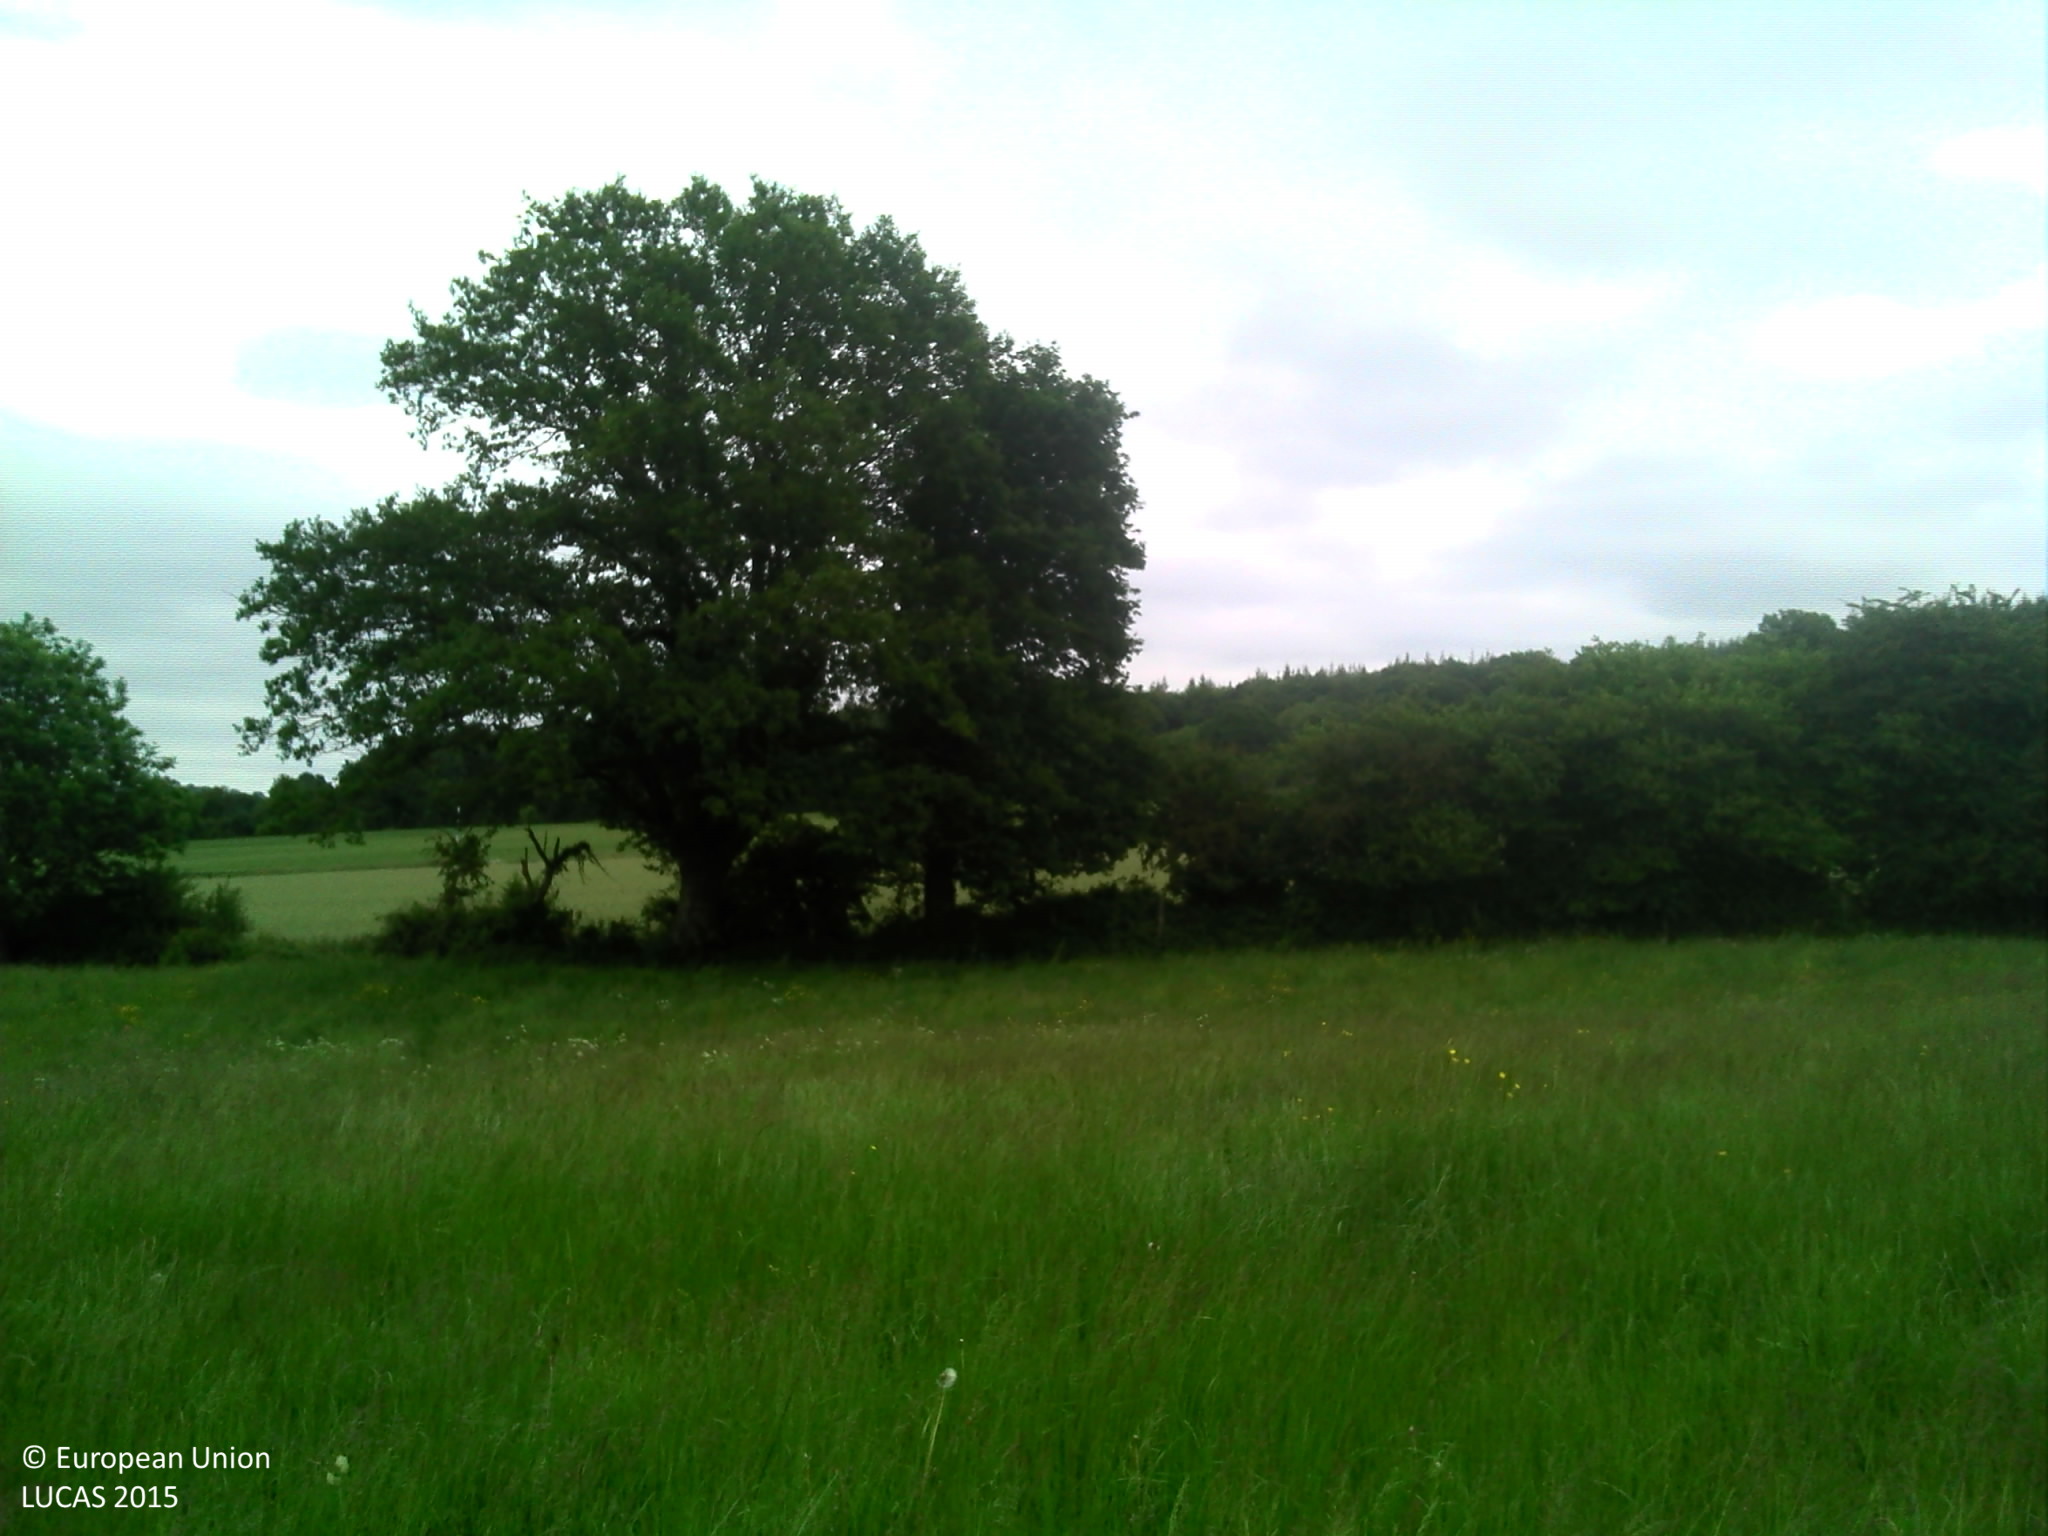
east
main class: Cropland
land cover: Rape and turnip rape
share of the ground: > 75 %
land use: Agriculture (excluding fallow land and kitchen gardens)
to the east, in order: Rape and turnip rape; Fences; Grassland without tree/shrub cover; Fences; Abandoned hedges; Triticale; Fences; Electric lines; Grass margins; Paved roads, cycling and walking lanes; Grass margins; Common wheat
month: May
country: FR
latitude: 48.2263
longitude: -0.1397
